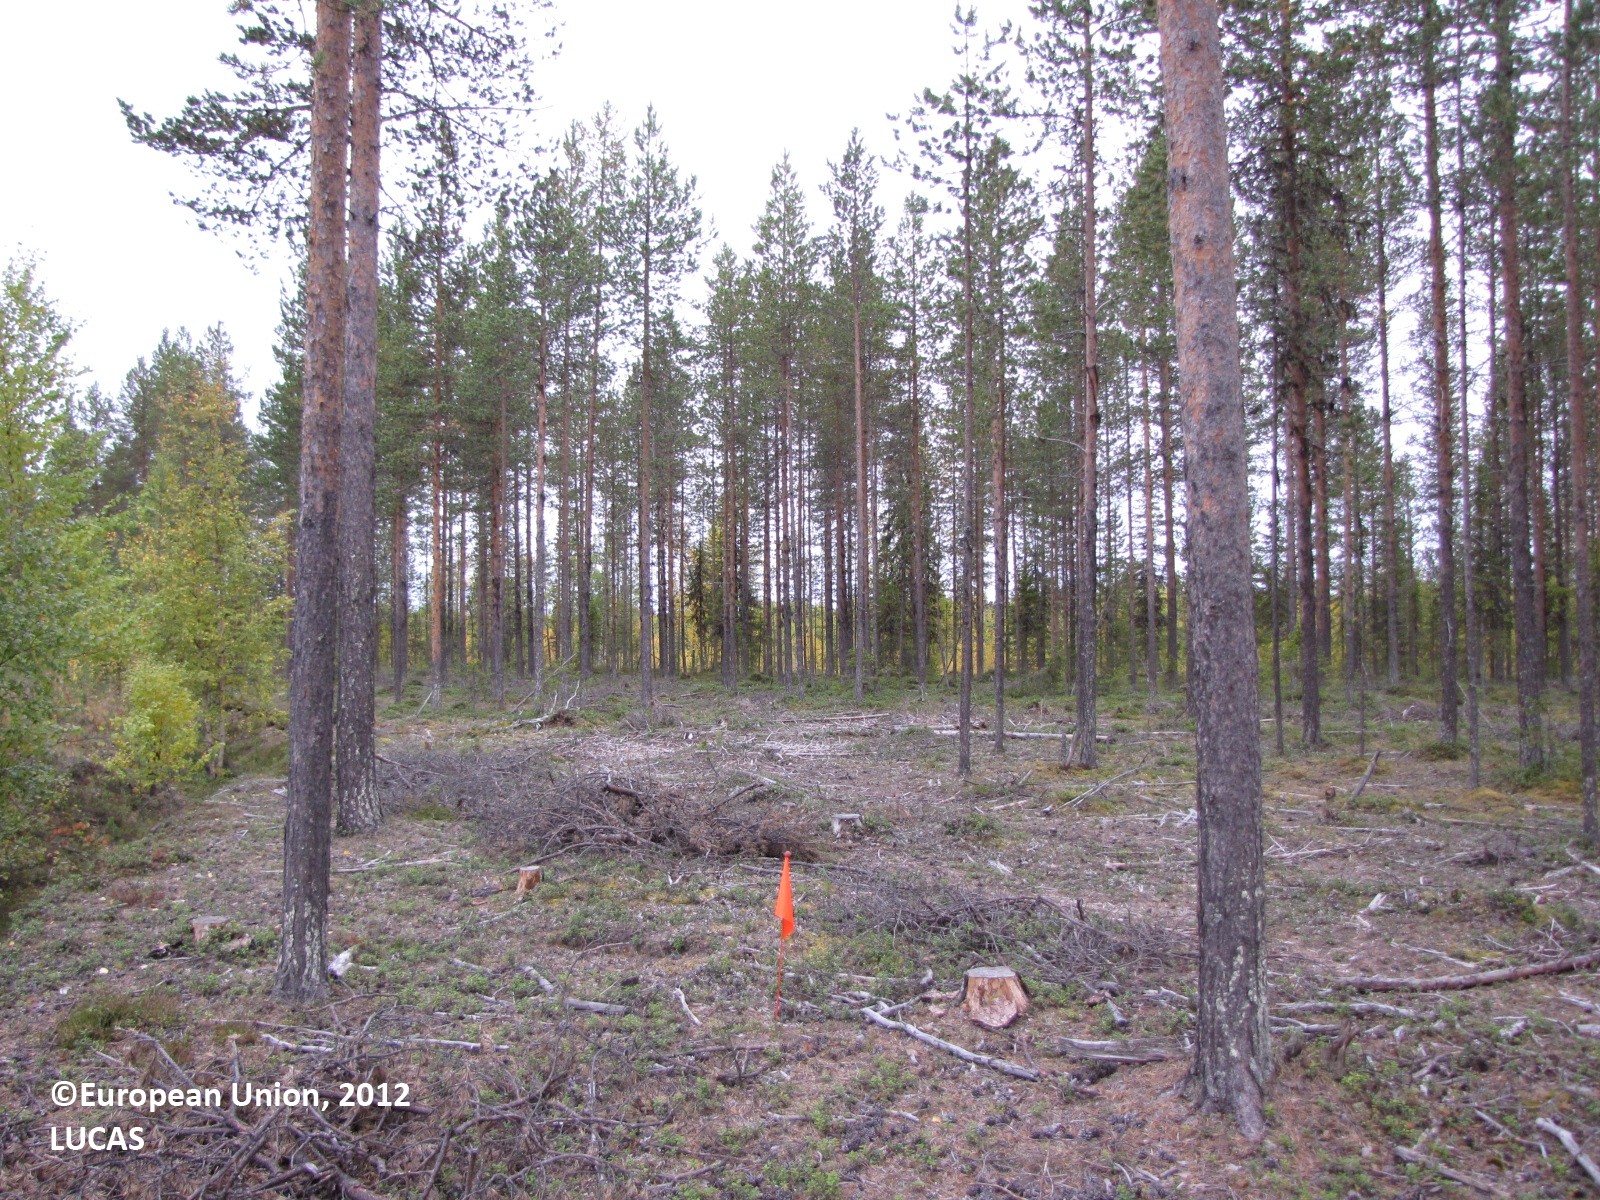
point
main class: Woodland
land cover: Pine dominated coniferous woodland
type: boreal forest
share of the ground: 50 - 75 %
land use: Forestry
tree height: > 5 m
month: September
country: FI
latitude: 67.2083
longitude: 24.8223
